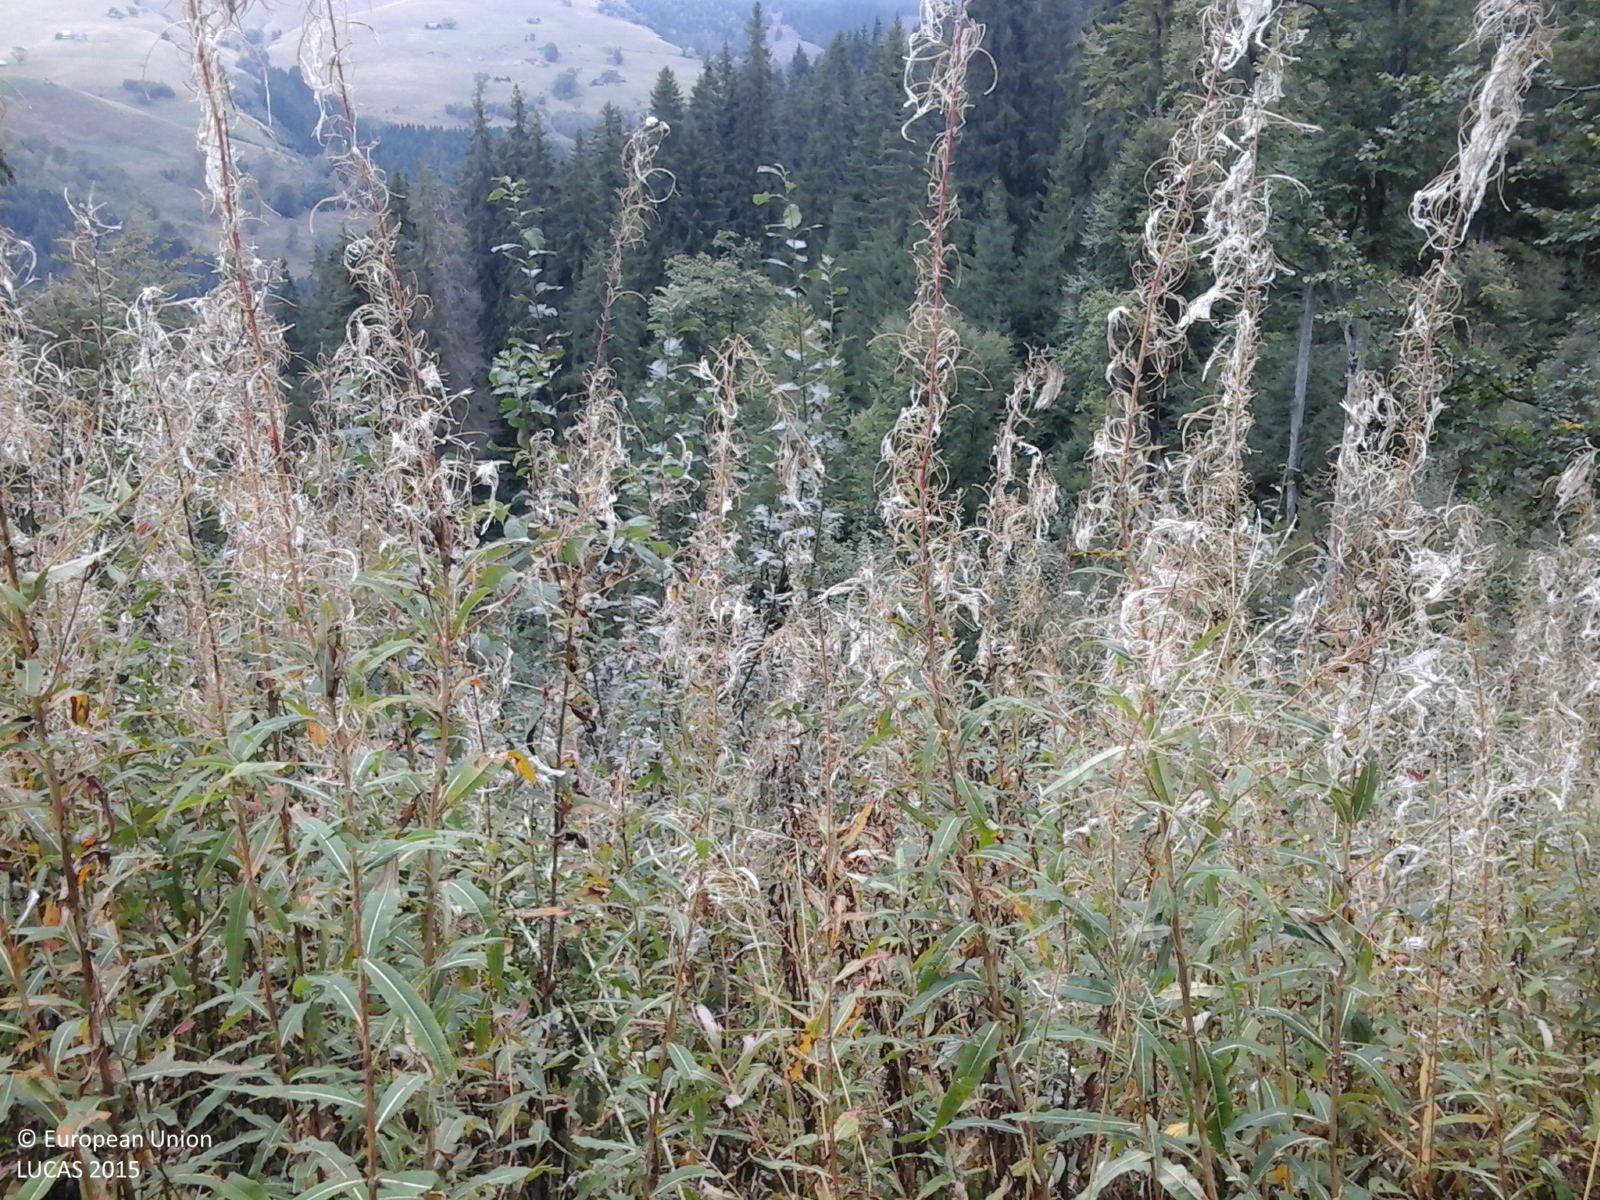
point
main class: Grassland
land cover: Spontaneously vegetated surfaces
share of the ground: > 75 %
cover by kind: herbaceous plants 100 %
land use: Forestry
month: September
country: RO
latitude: 45.6709
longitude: 23.6589
